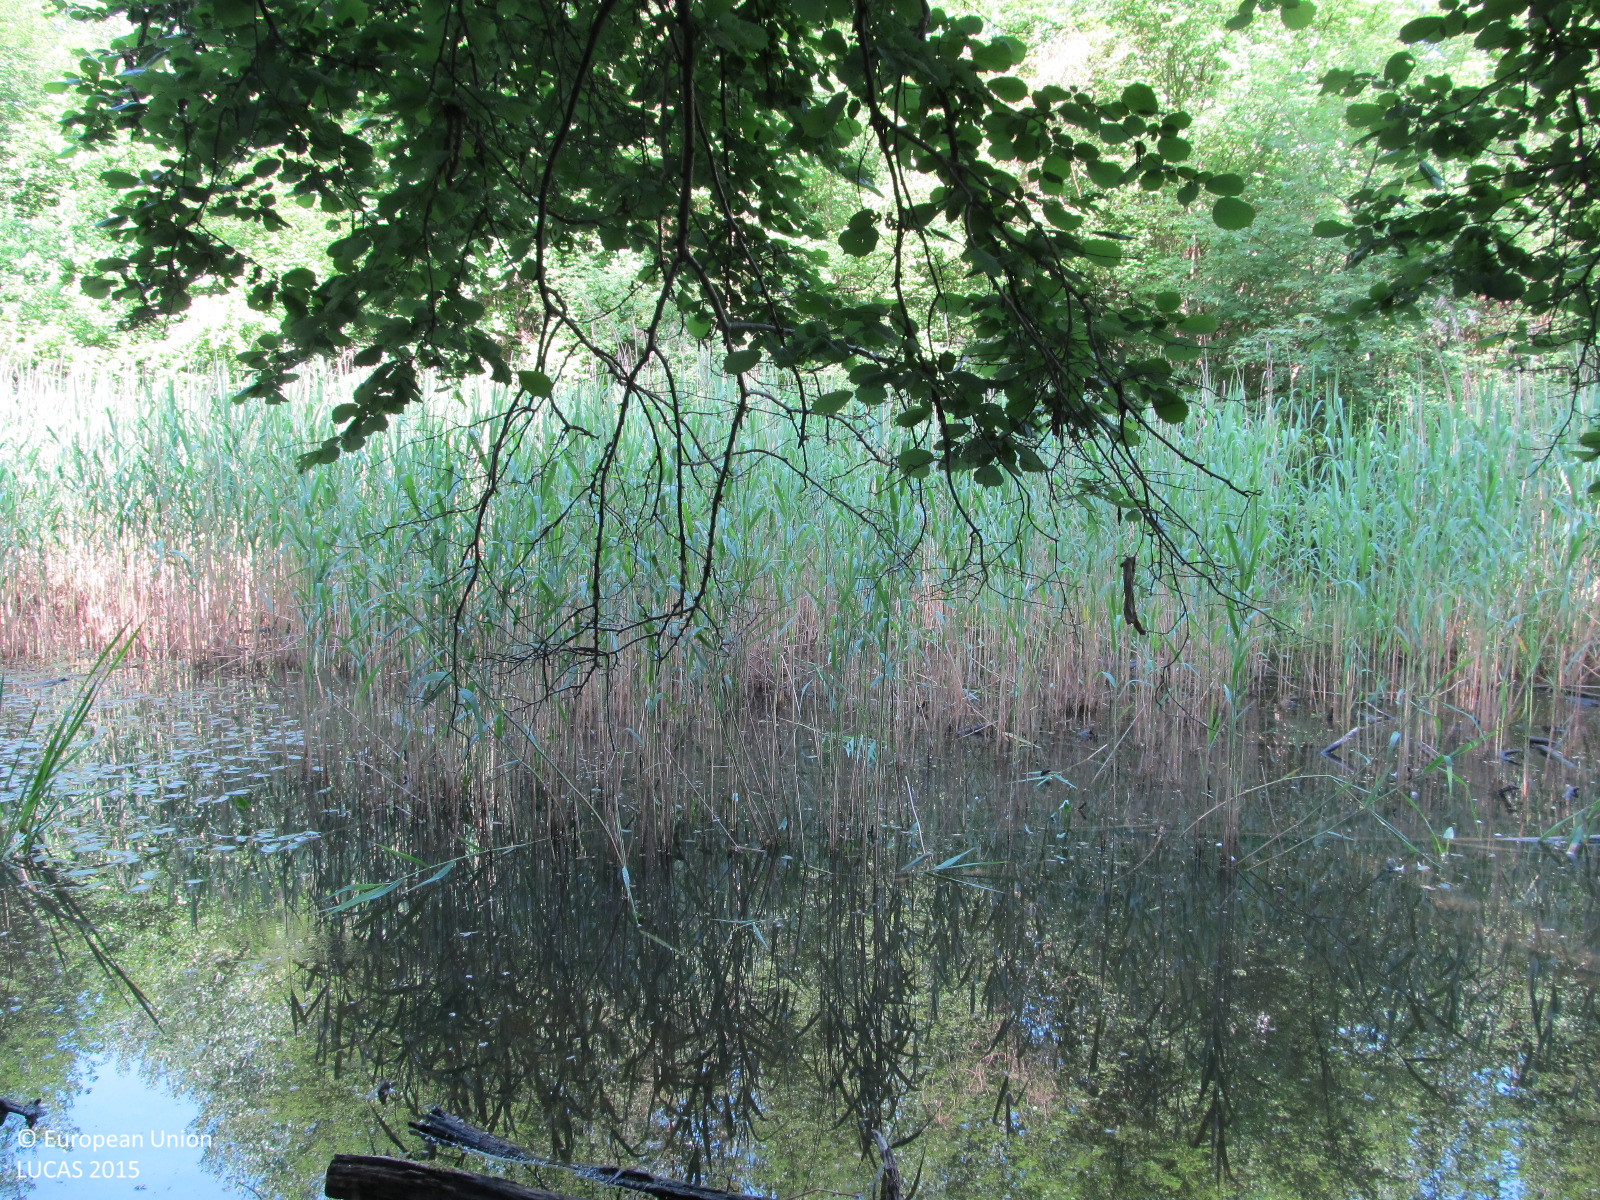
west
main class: Woodland
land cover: Broadleaved woodland
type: floodplain forest
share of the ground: 50 - 75 %
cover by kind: broadleaved forest trees 70 %, shrubs 20 %, herbaceous plants 10 %
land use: Forestry
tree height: > 5 m
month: May
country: AT
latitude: 48.3957
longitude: 15.7975
